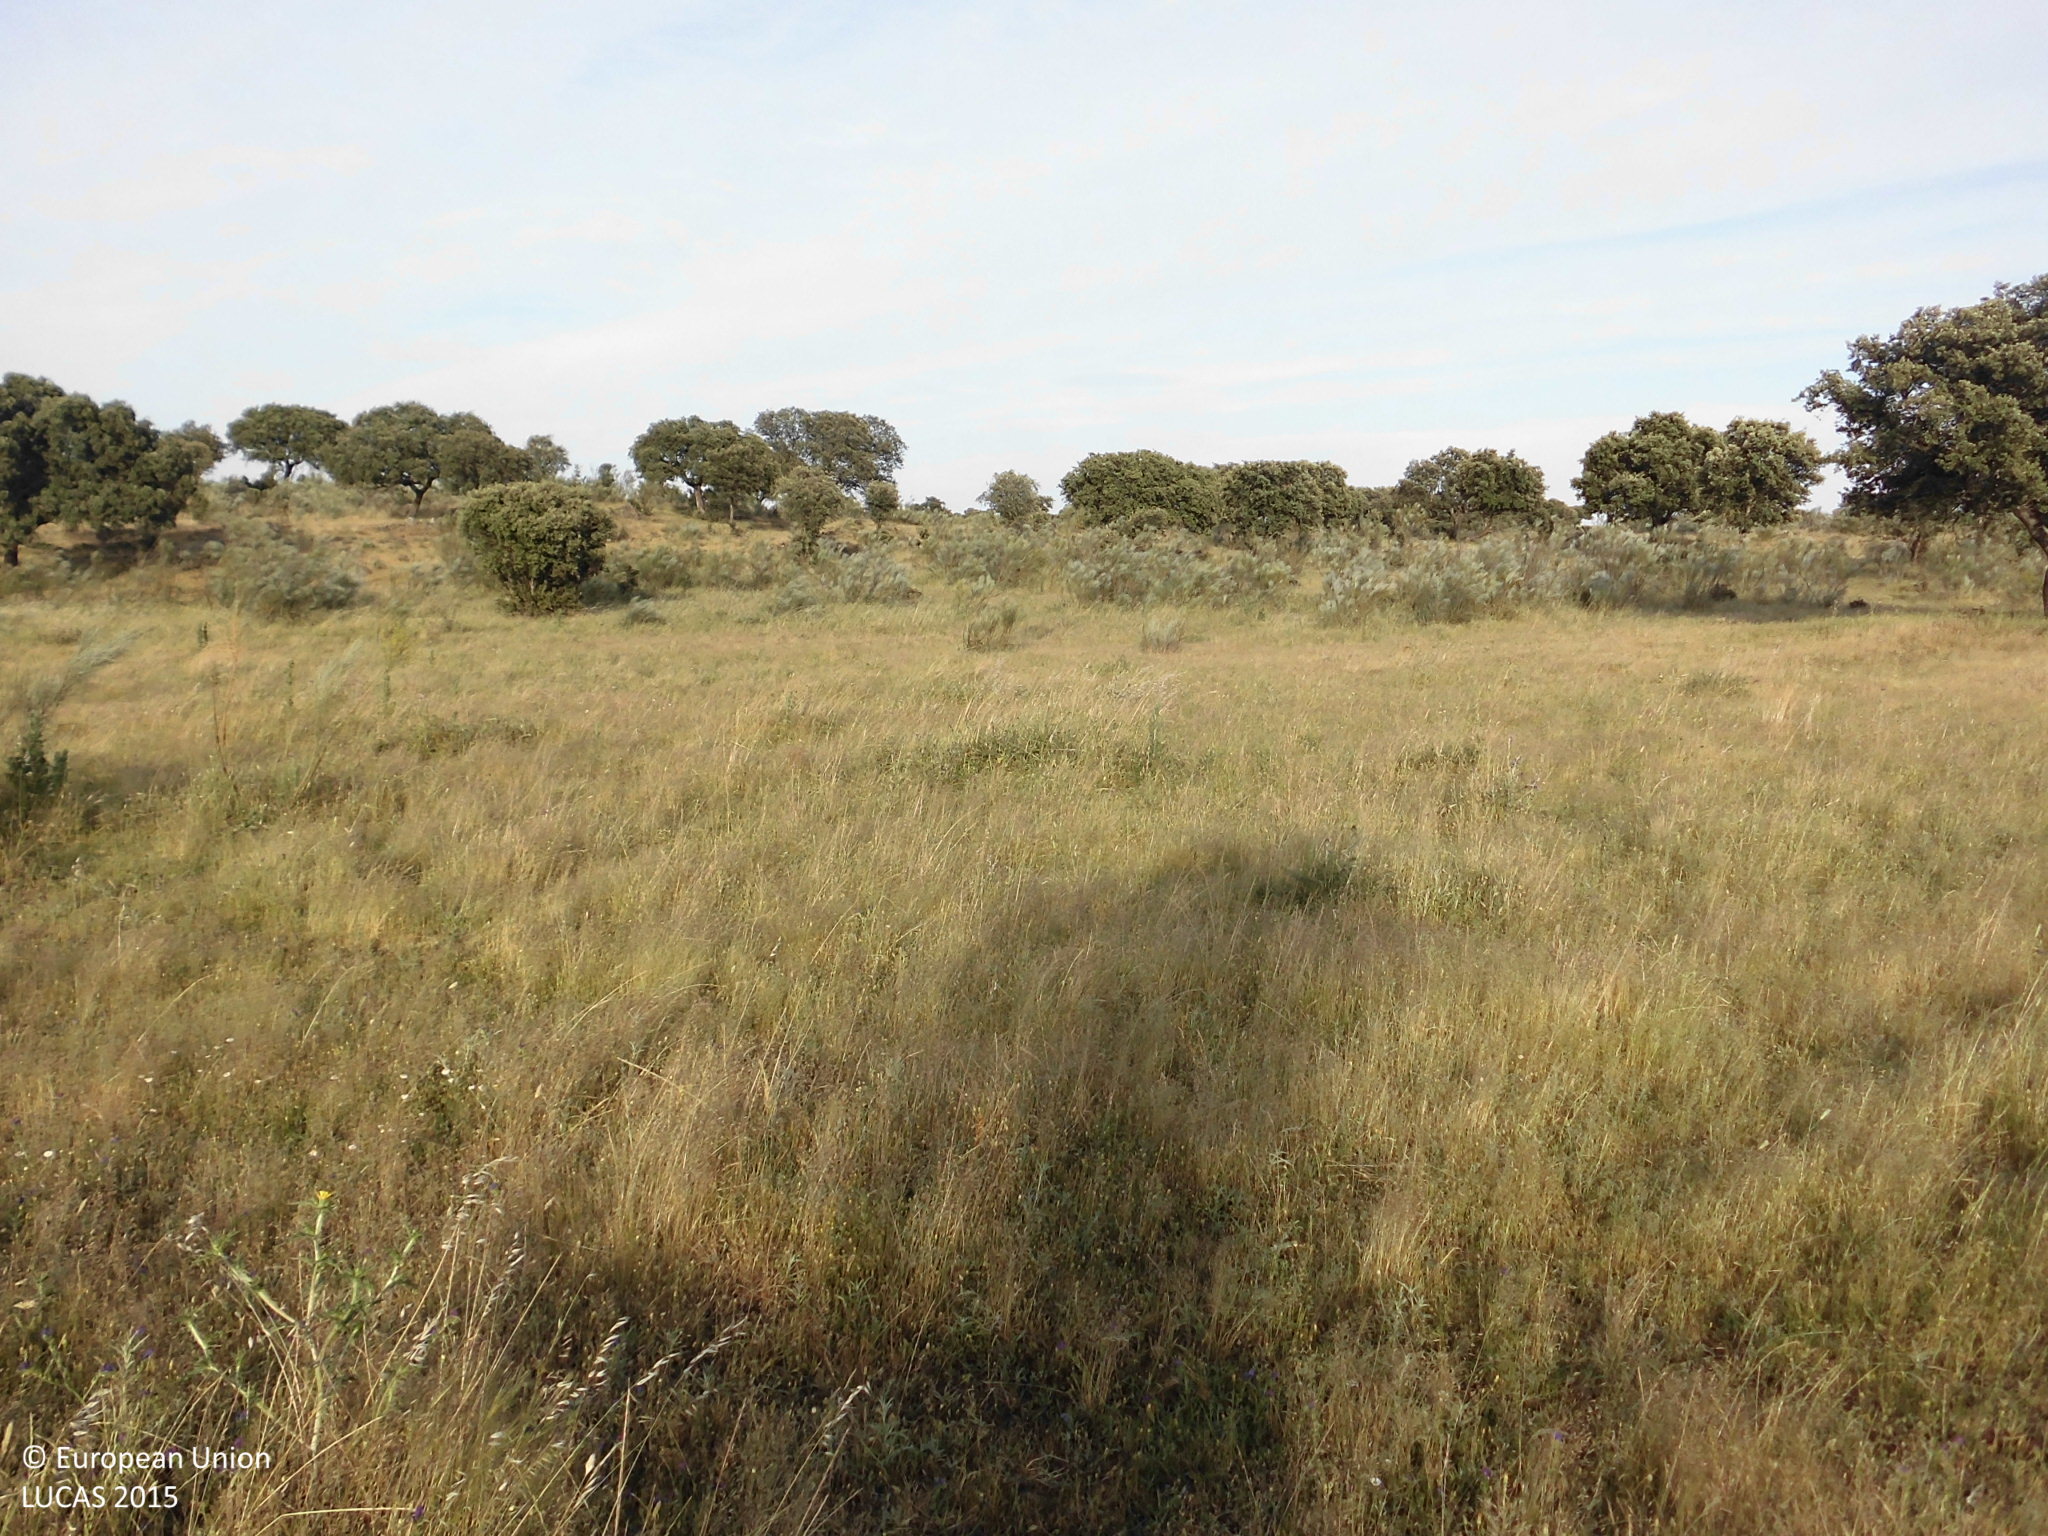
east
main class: Shrubland
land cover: Shrubland without tree cover
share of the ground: 10 - 25 %
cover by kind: herbaceous plants 90 %, shrubs 10 %
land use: Agriculture (excluding fallow land and kitchen gardens)
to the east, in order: Shrubland without tree cover; Broadleaved woodland
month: May
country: ES
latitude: 39.5693
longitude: -6.1167
